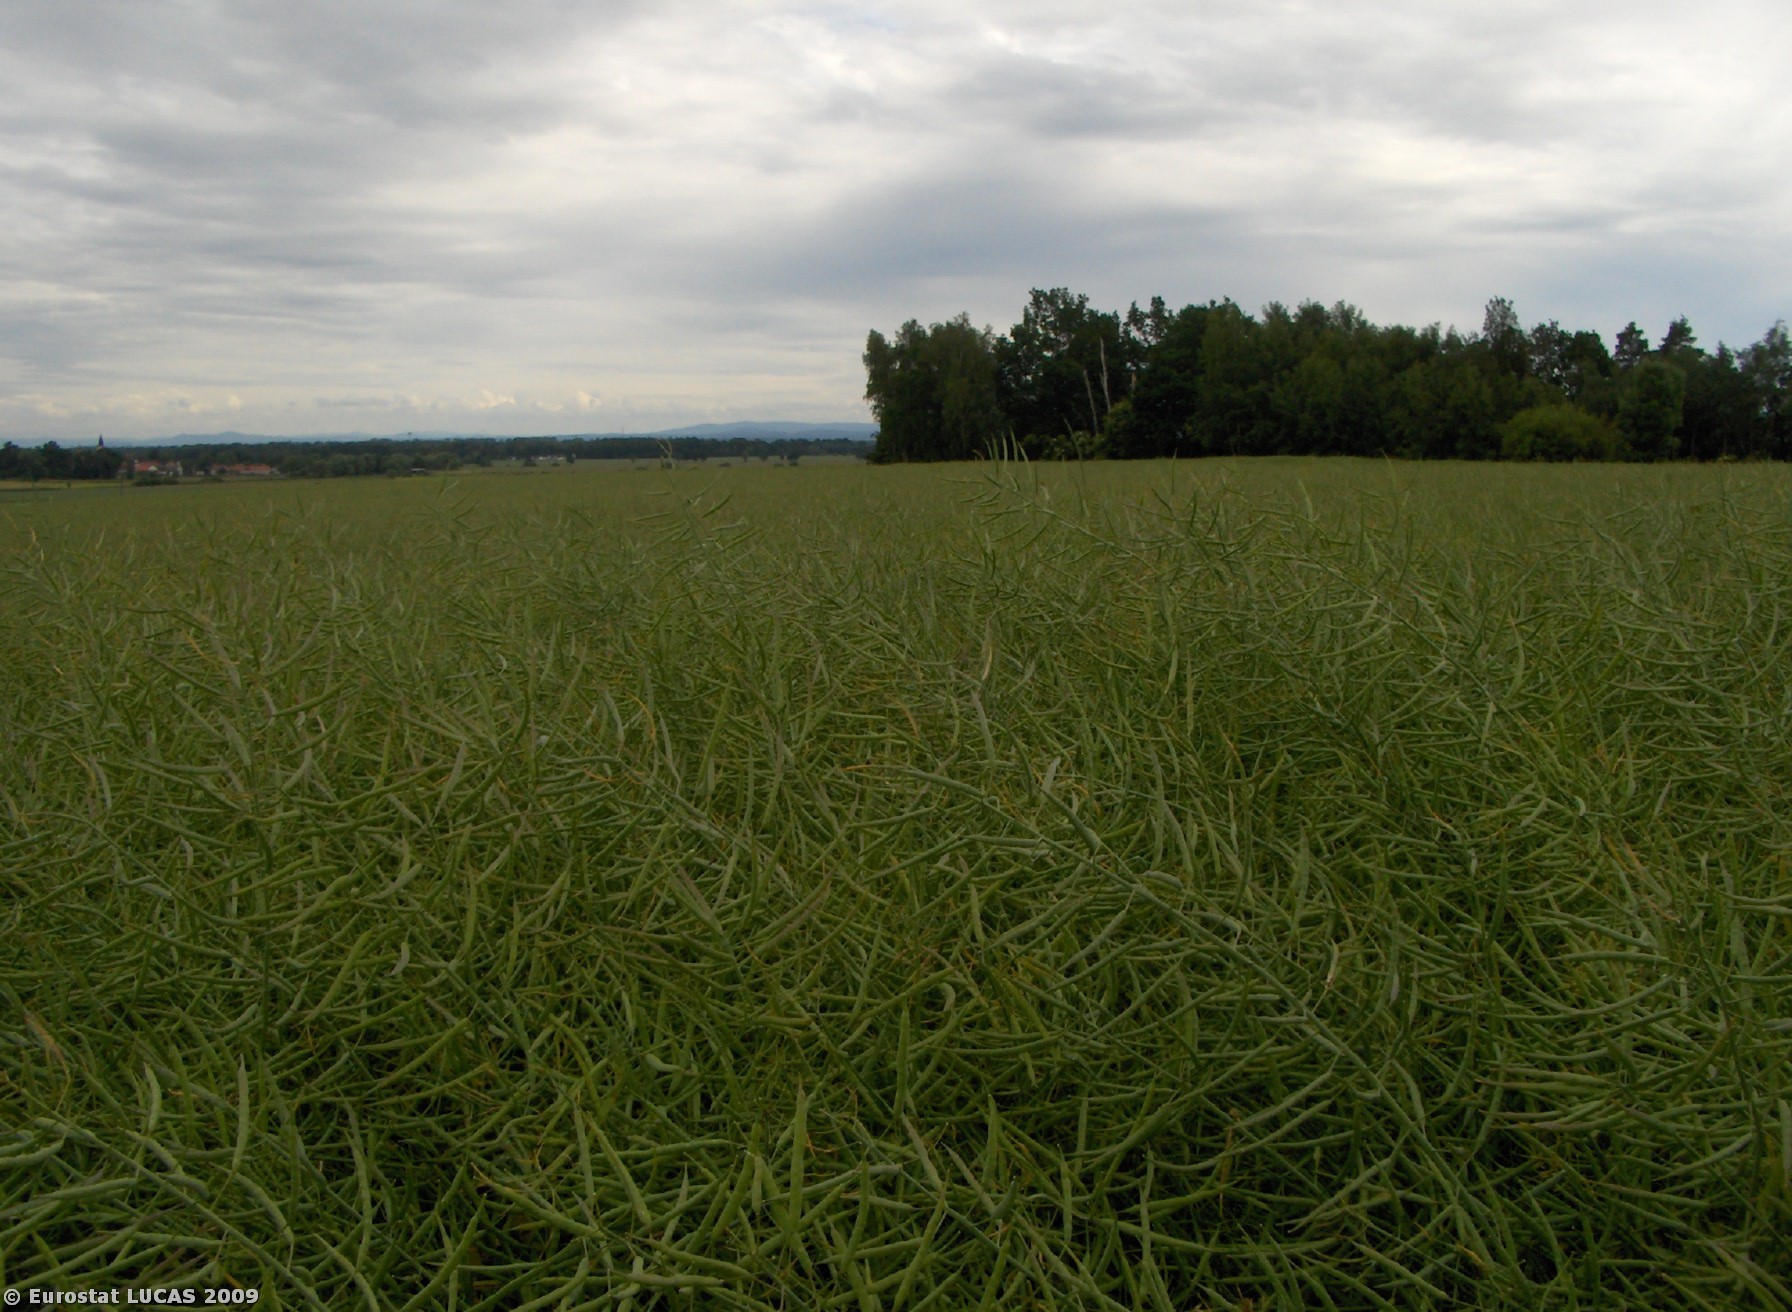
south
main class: Cropland
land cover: Rape and turnip rape
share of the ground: > 75 %
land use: Agriculture (excluding fallow land and kitchen gardens)
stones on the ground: < 10 %
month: June
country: CZ
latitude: 49.1299
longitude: 14.3179
